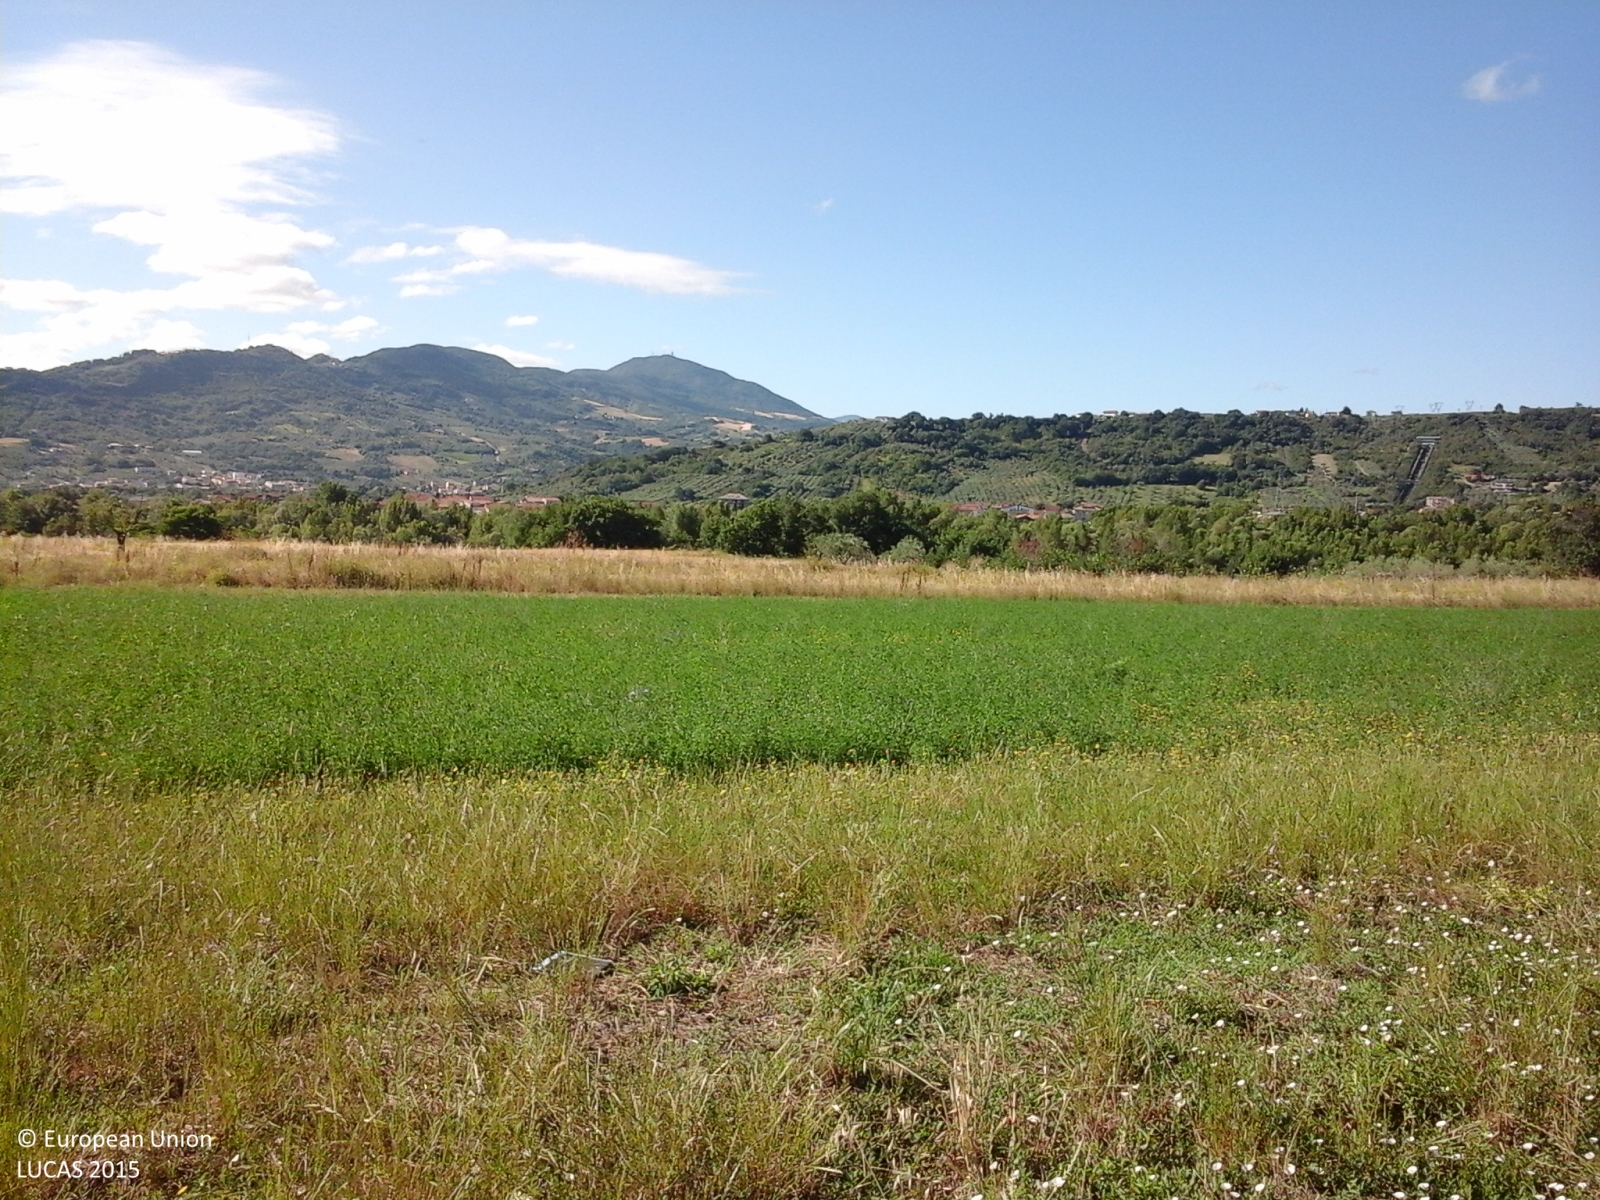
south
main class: Cropland
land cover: Other leguminous and mixtures for fodder
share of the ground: > 75 %
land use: Agriculture (excluding fallow land and kitchen gardens)
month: June
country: IT
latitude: 42.1264
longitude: 14.3532
